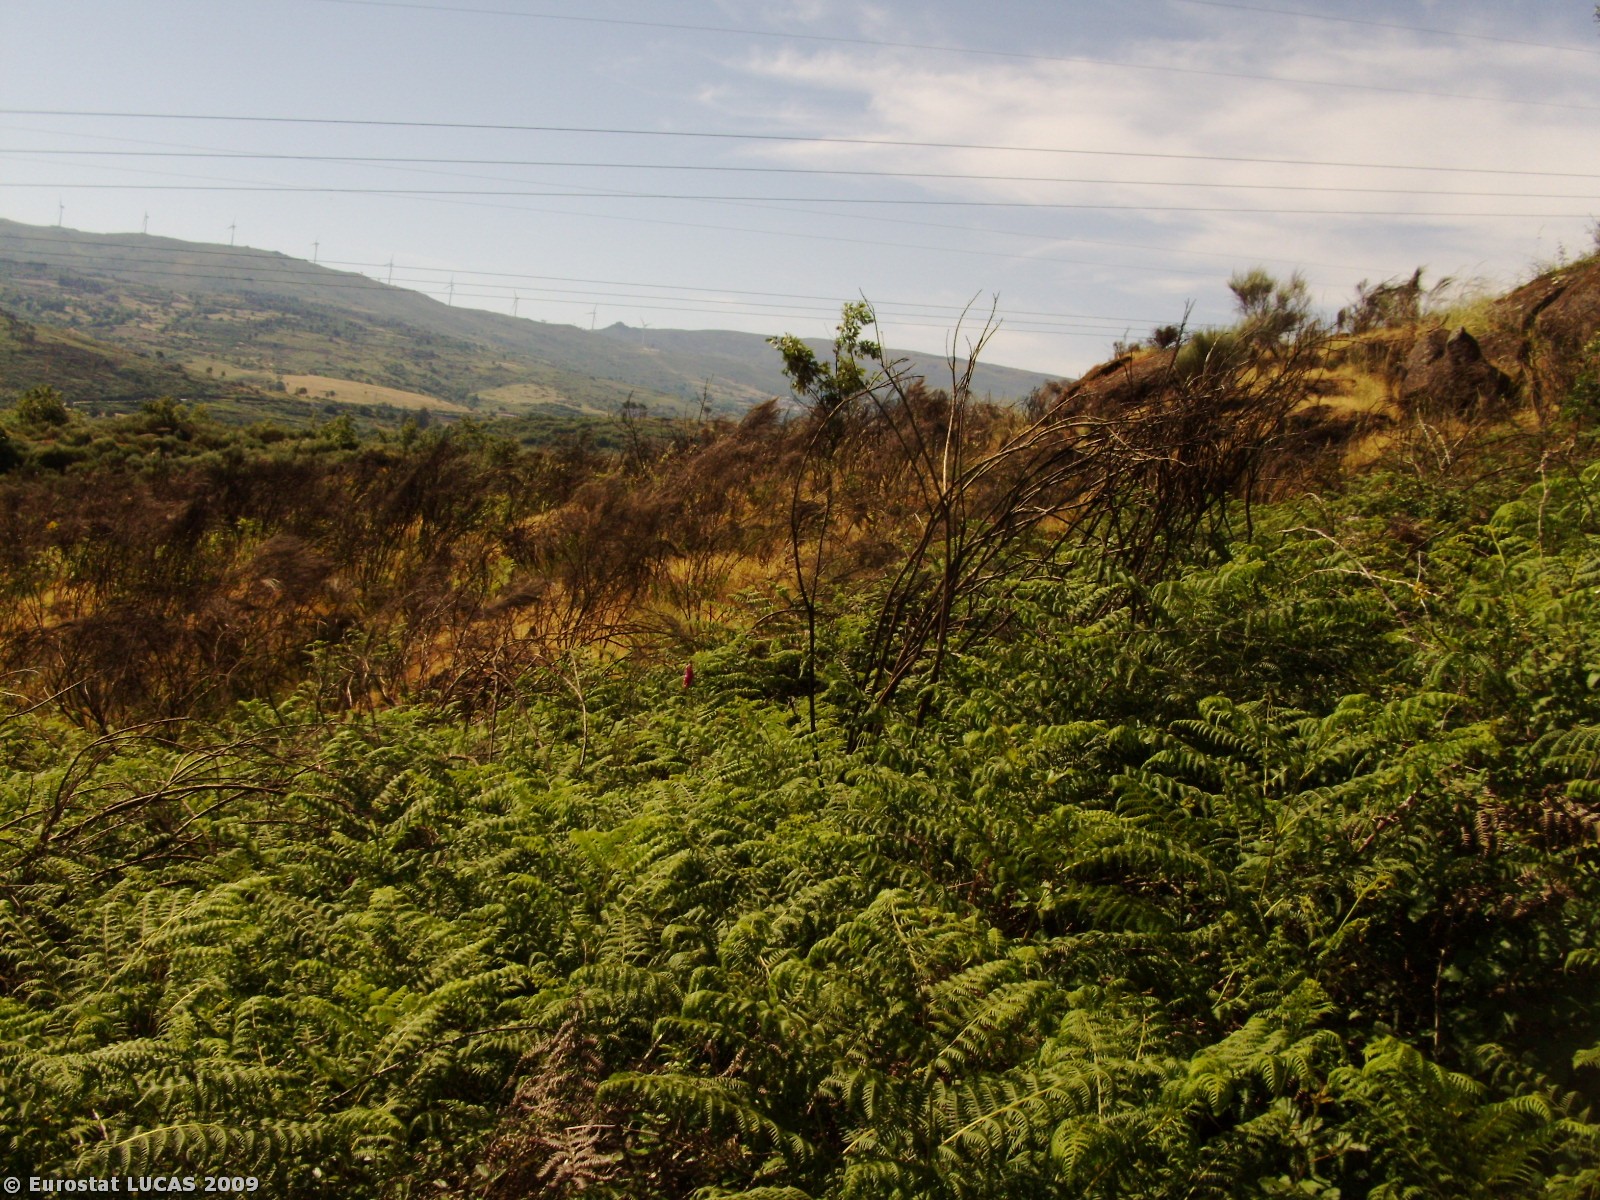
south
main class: Shrubland
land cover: Shrubland with sparse tree cover
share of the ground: > 75 %
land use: Fallow land
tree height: > 5 m
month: June
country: PT
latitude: 40.6090
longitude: -7.4499
